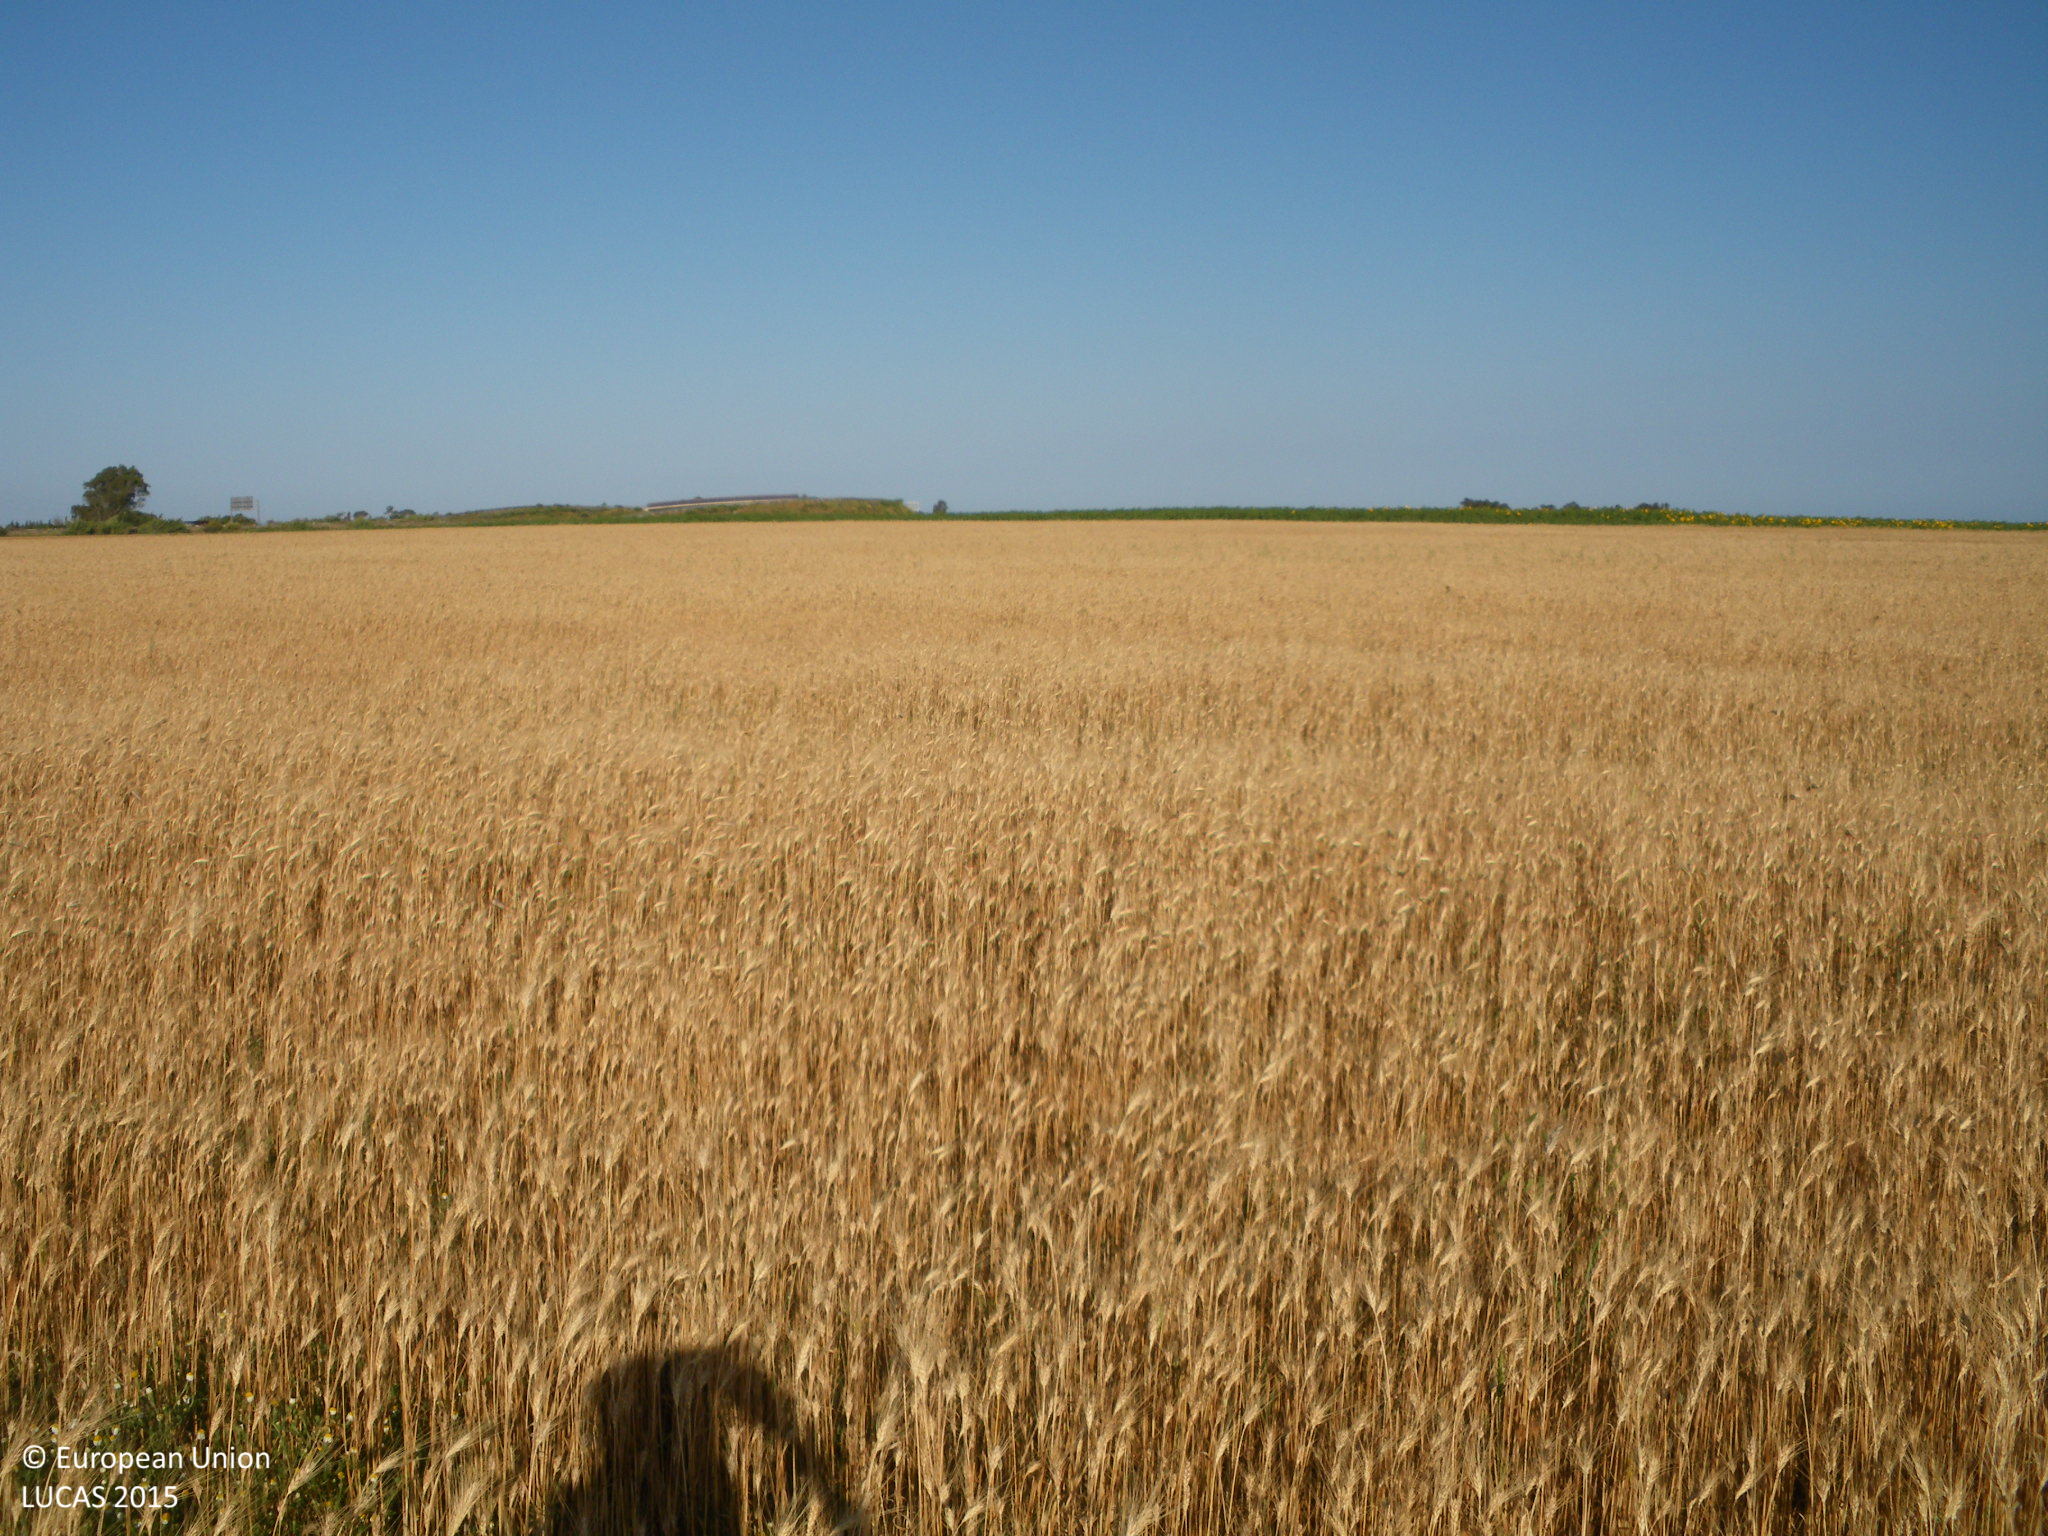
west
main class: Cropland
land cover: Durum wheat
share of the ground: > 75 %
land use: Agriculture (excluding fallow land and kitchen gardens)
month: May
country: ES
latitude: 36.3541
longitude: -6.0621
